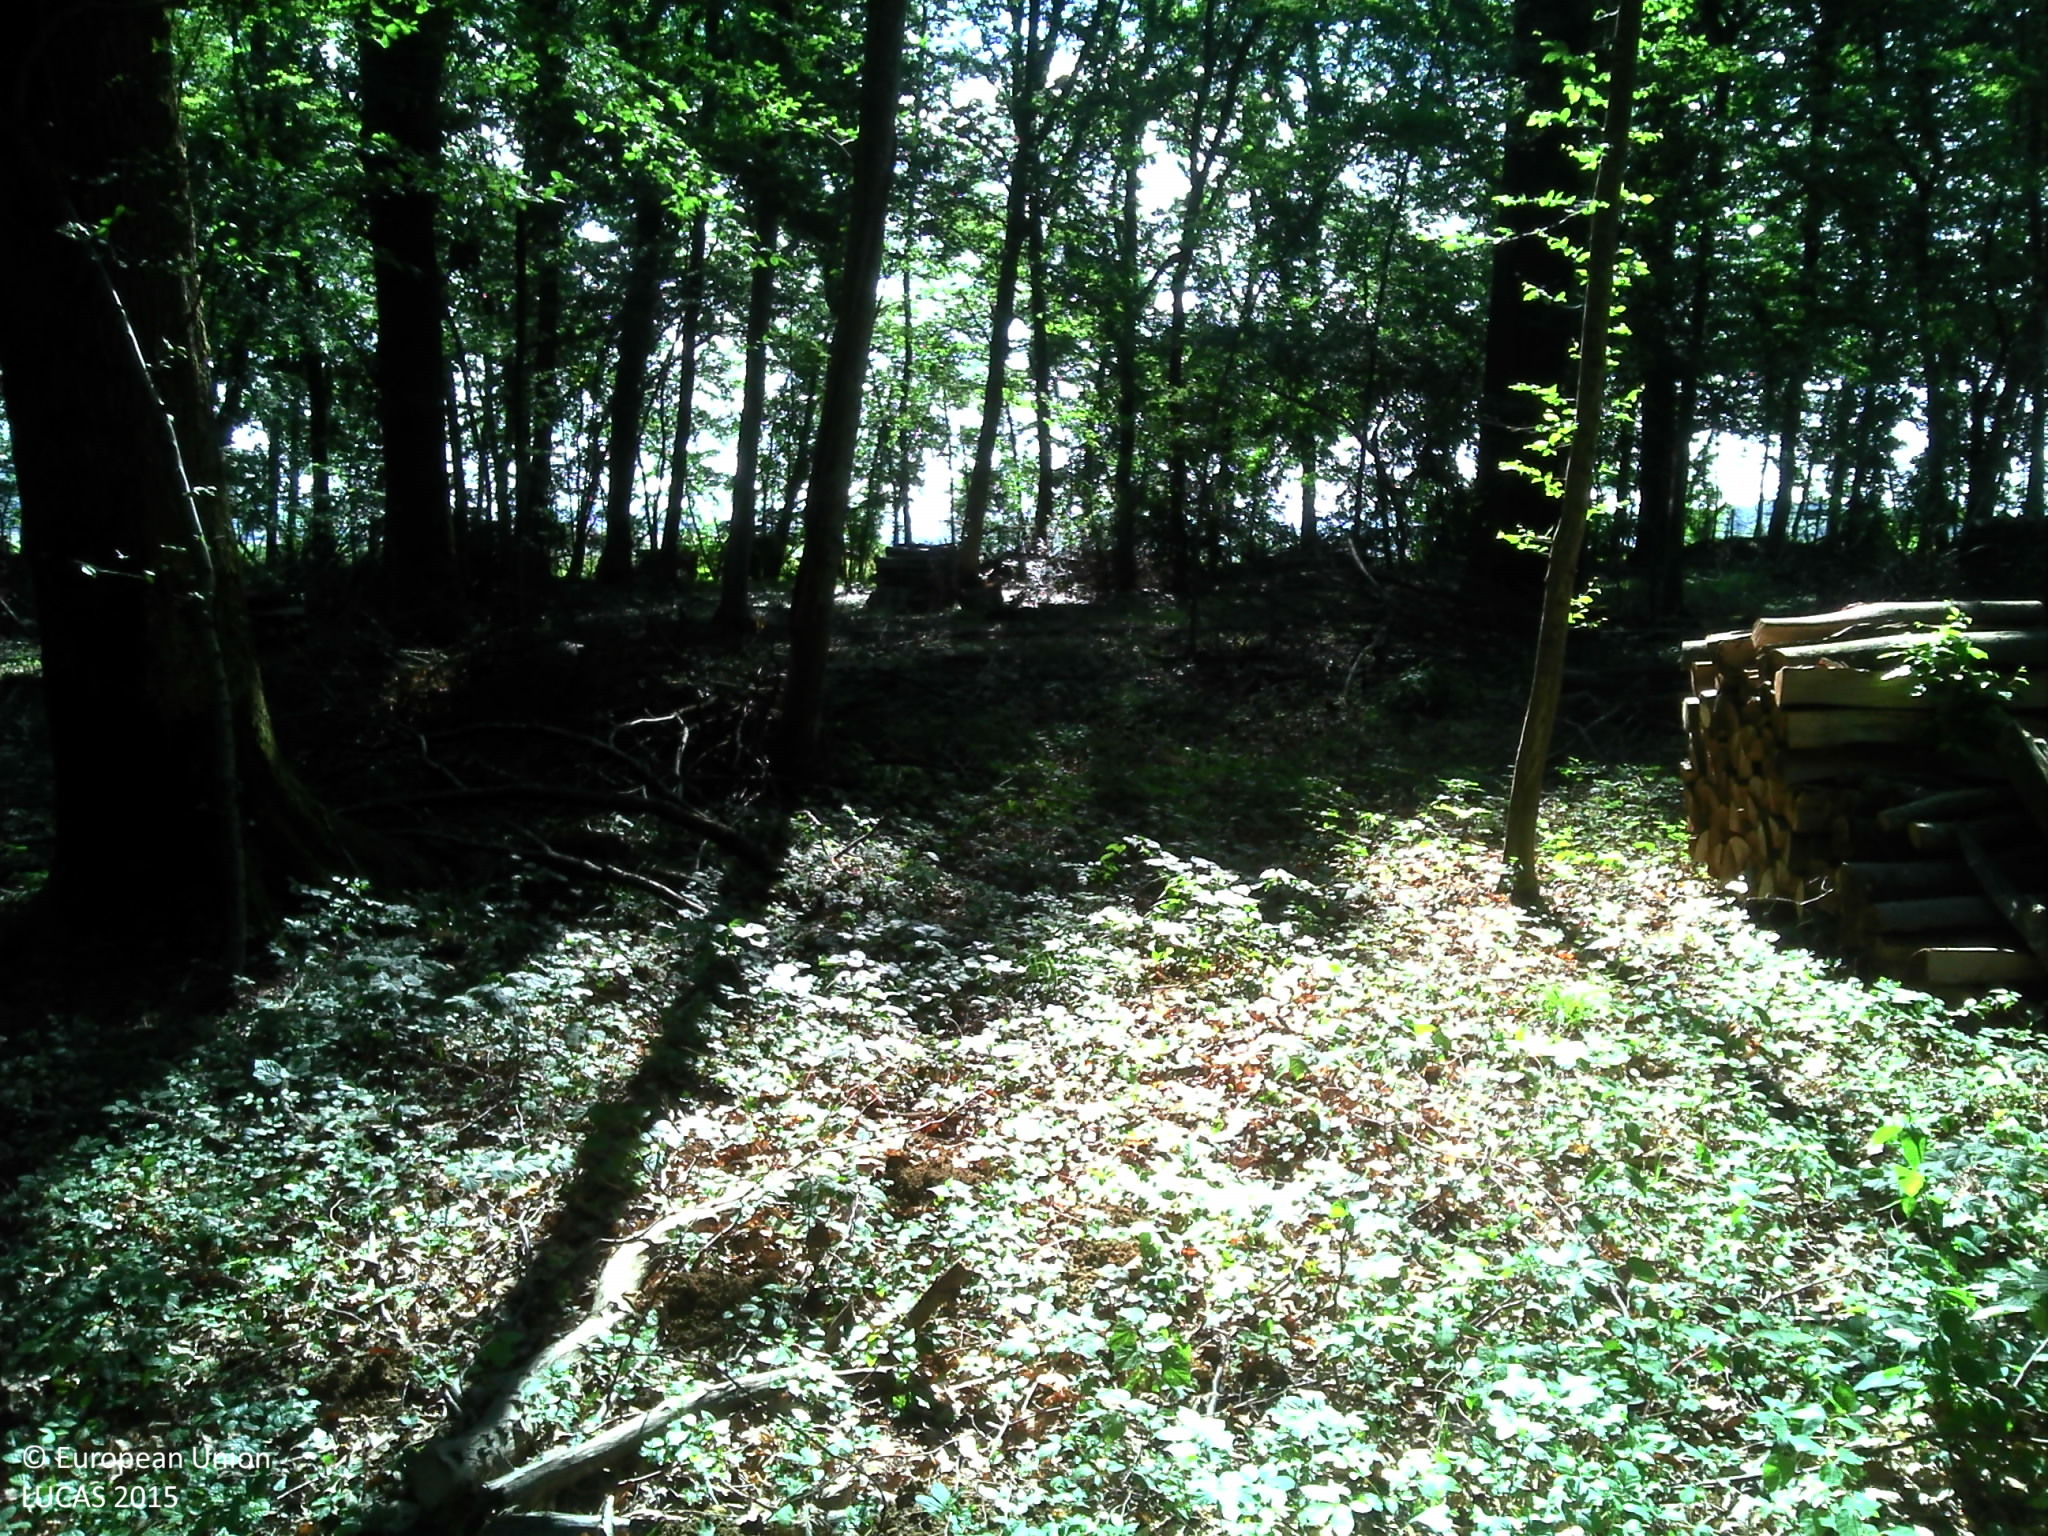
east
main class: Woodland
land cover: Broadleaved woodland
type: acidophilous oak and oak-birch forest
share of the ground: > 75 %
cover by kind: broadleaved forest trees 90 %, herbaceous plants 5 %, lichens and mosses 5 %
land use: Forestry
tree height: > 5 m
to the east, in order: Broadleaved woodland; Ditches and canals; Broadleaved woodland; Ditches and canals; Spontaneously vegetated surfaces; Rape and turnip rape
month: June
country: FR
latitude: 48.6897
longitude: 6.4819
